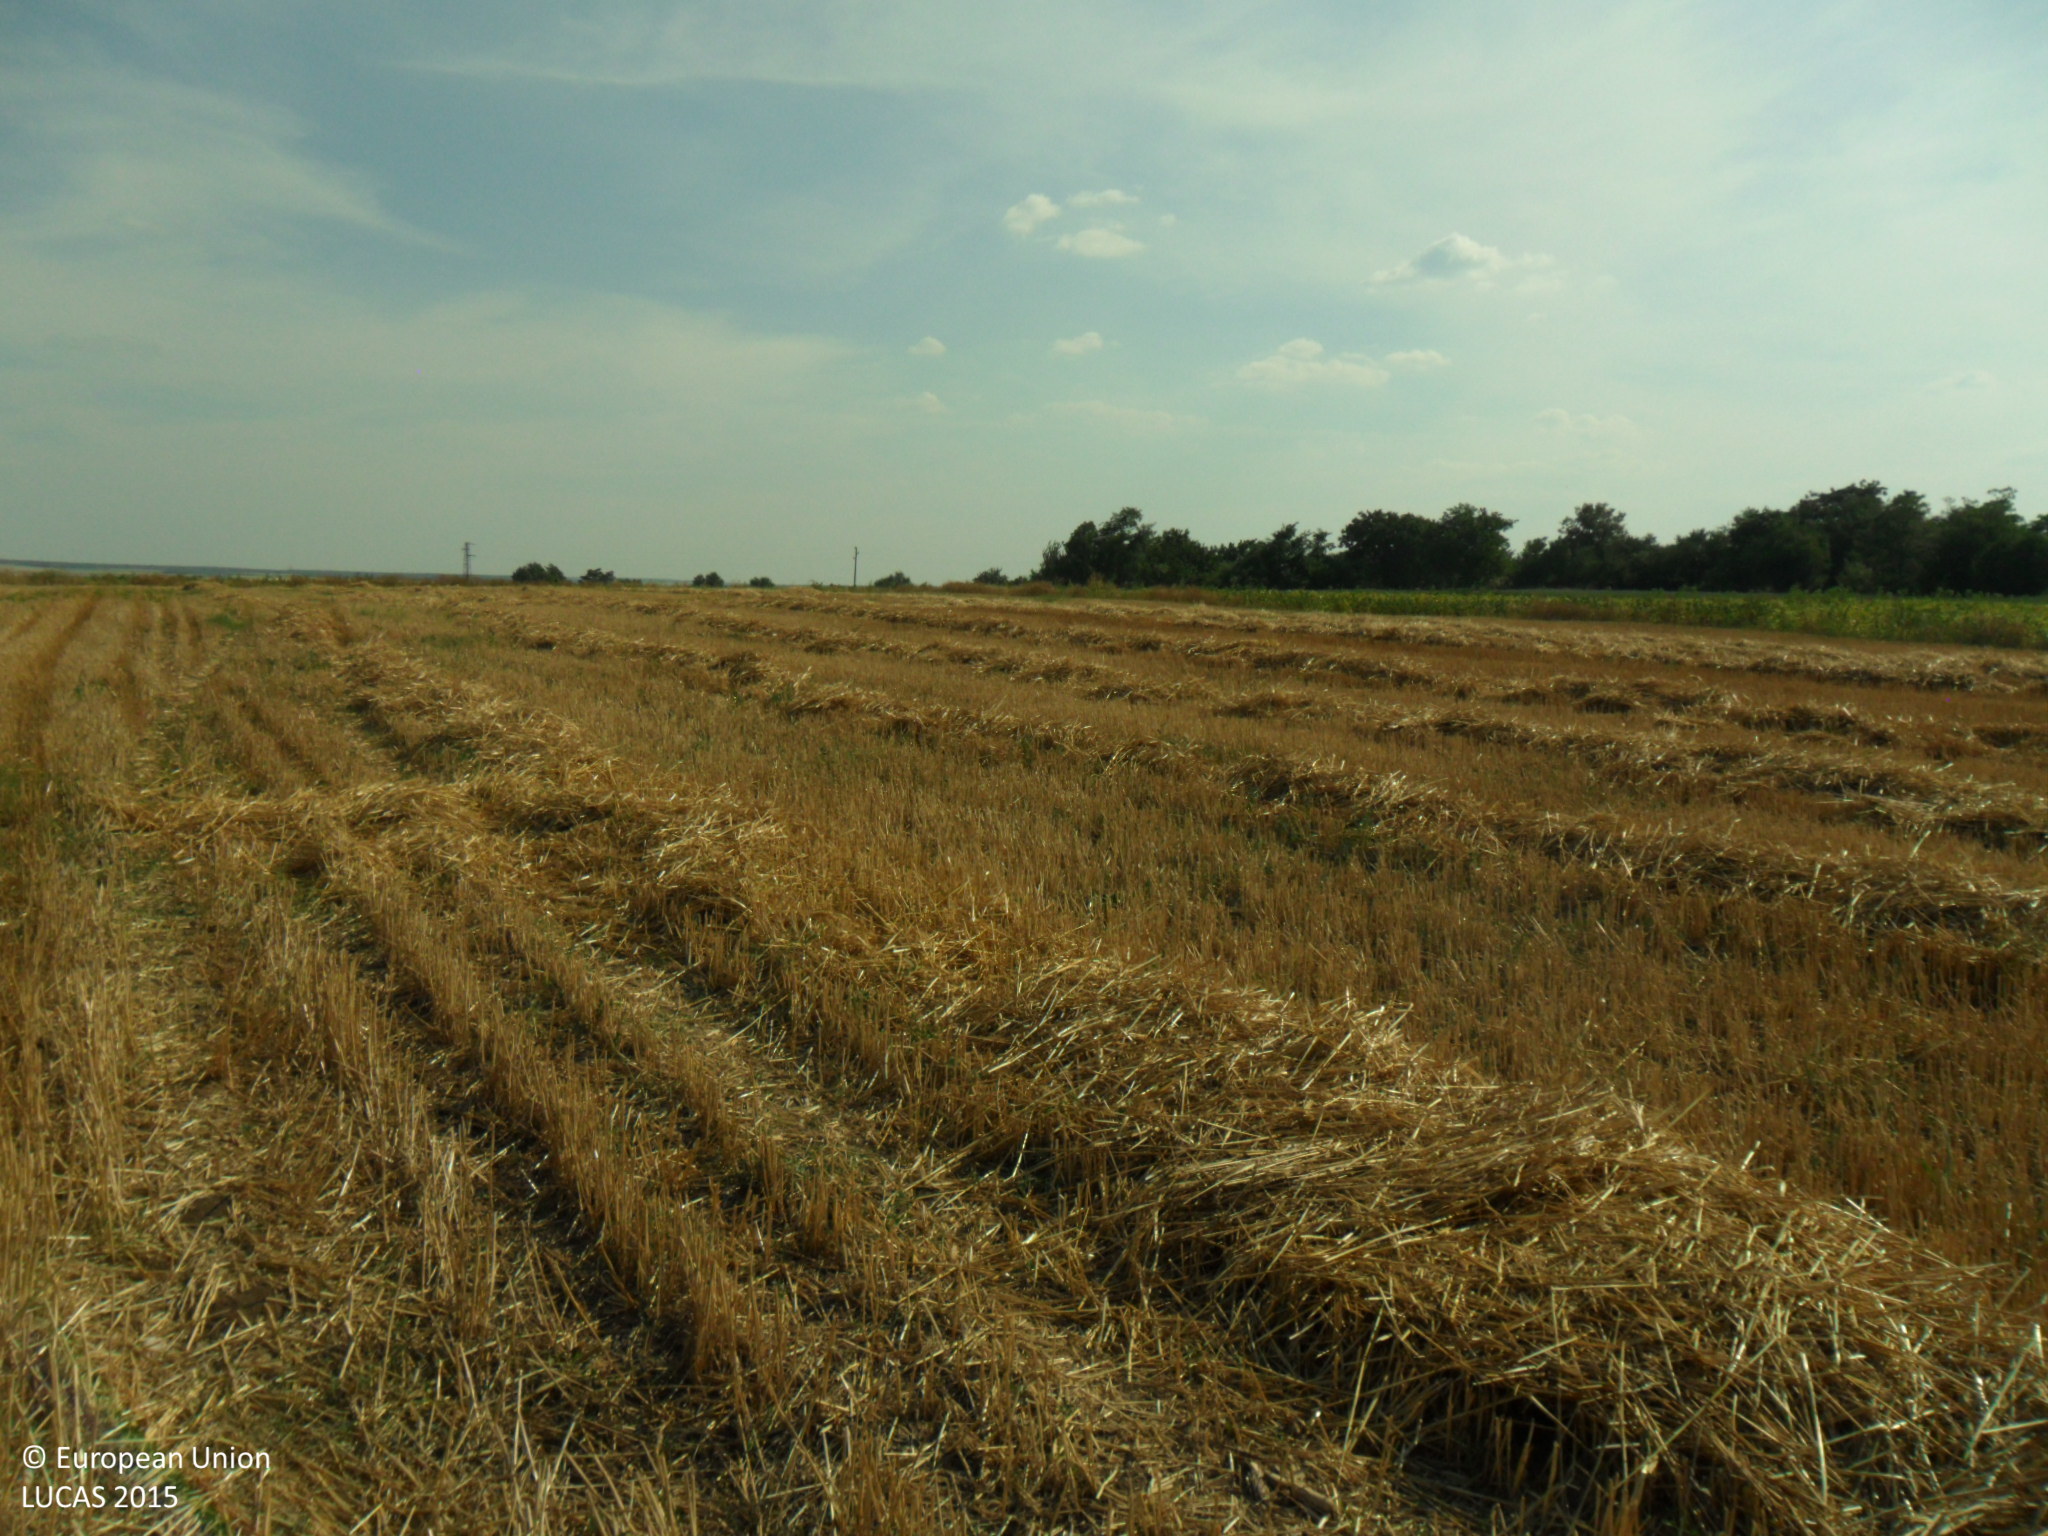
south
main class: Cropland
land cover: Common wheat
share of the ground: 25 - 50 %
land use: Agriculture (excluding fallow land and kitchen gardens)
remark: Harvested field
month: August
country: BG
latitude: 43.6428
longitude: 27.1692
